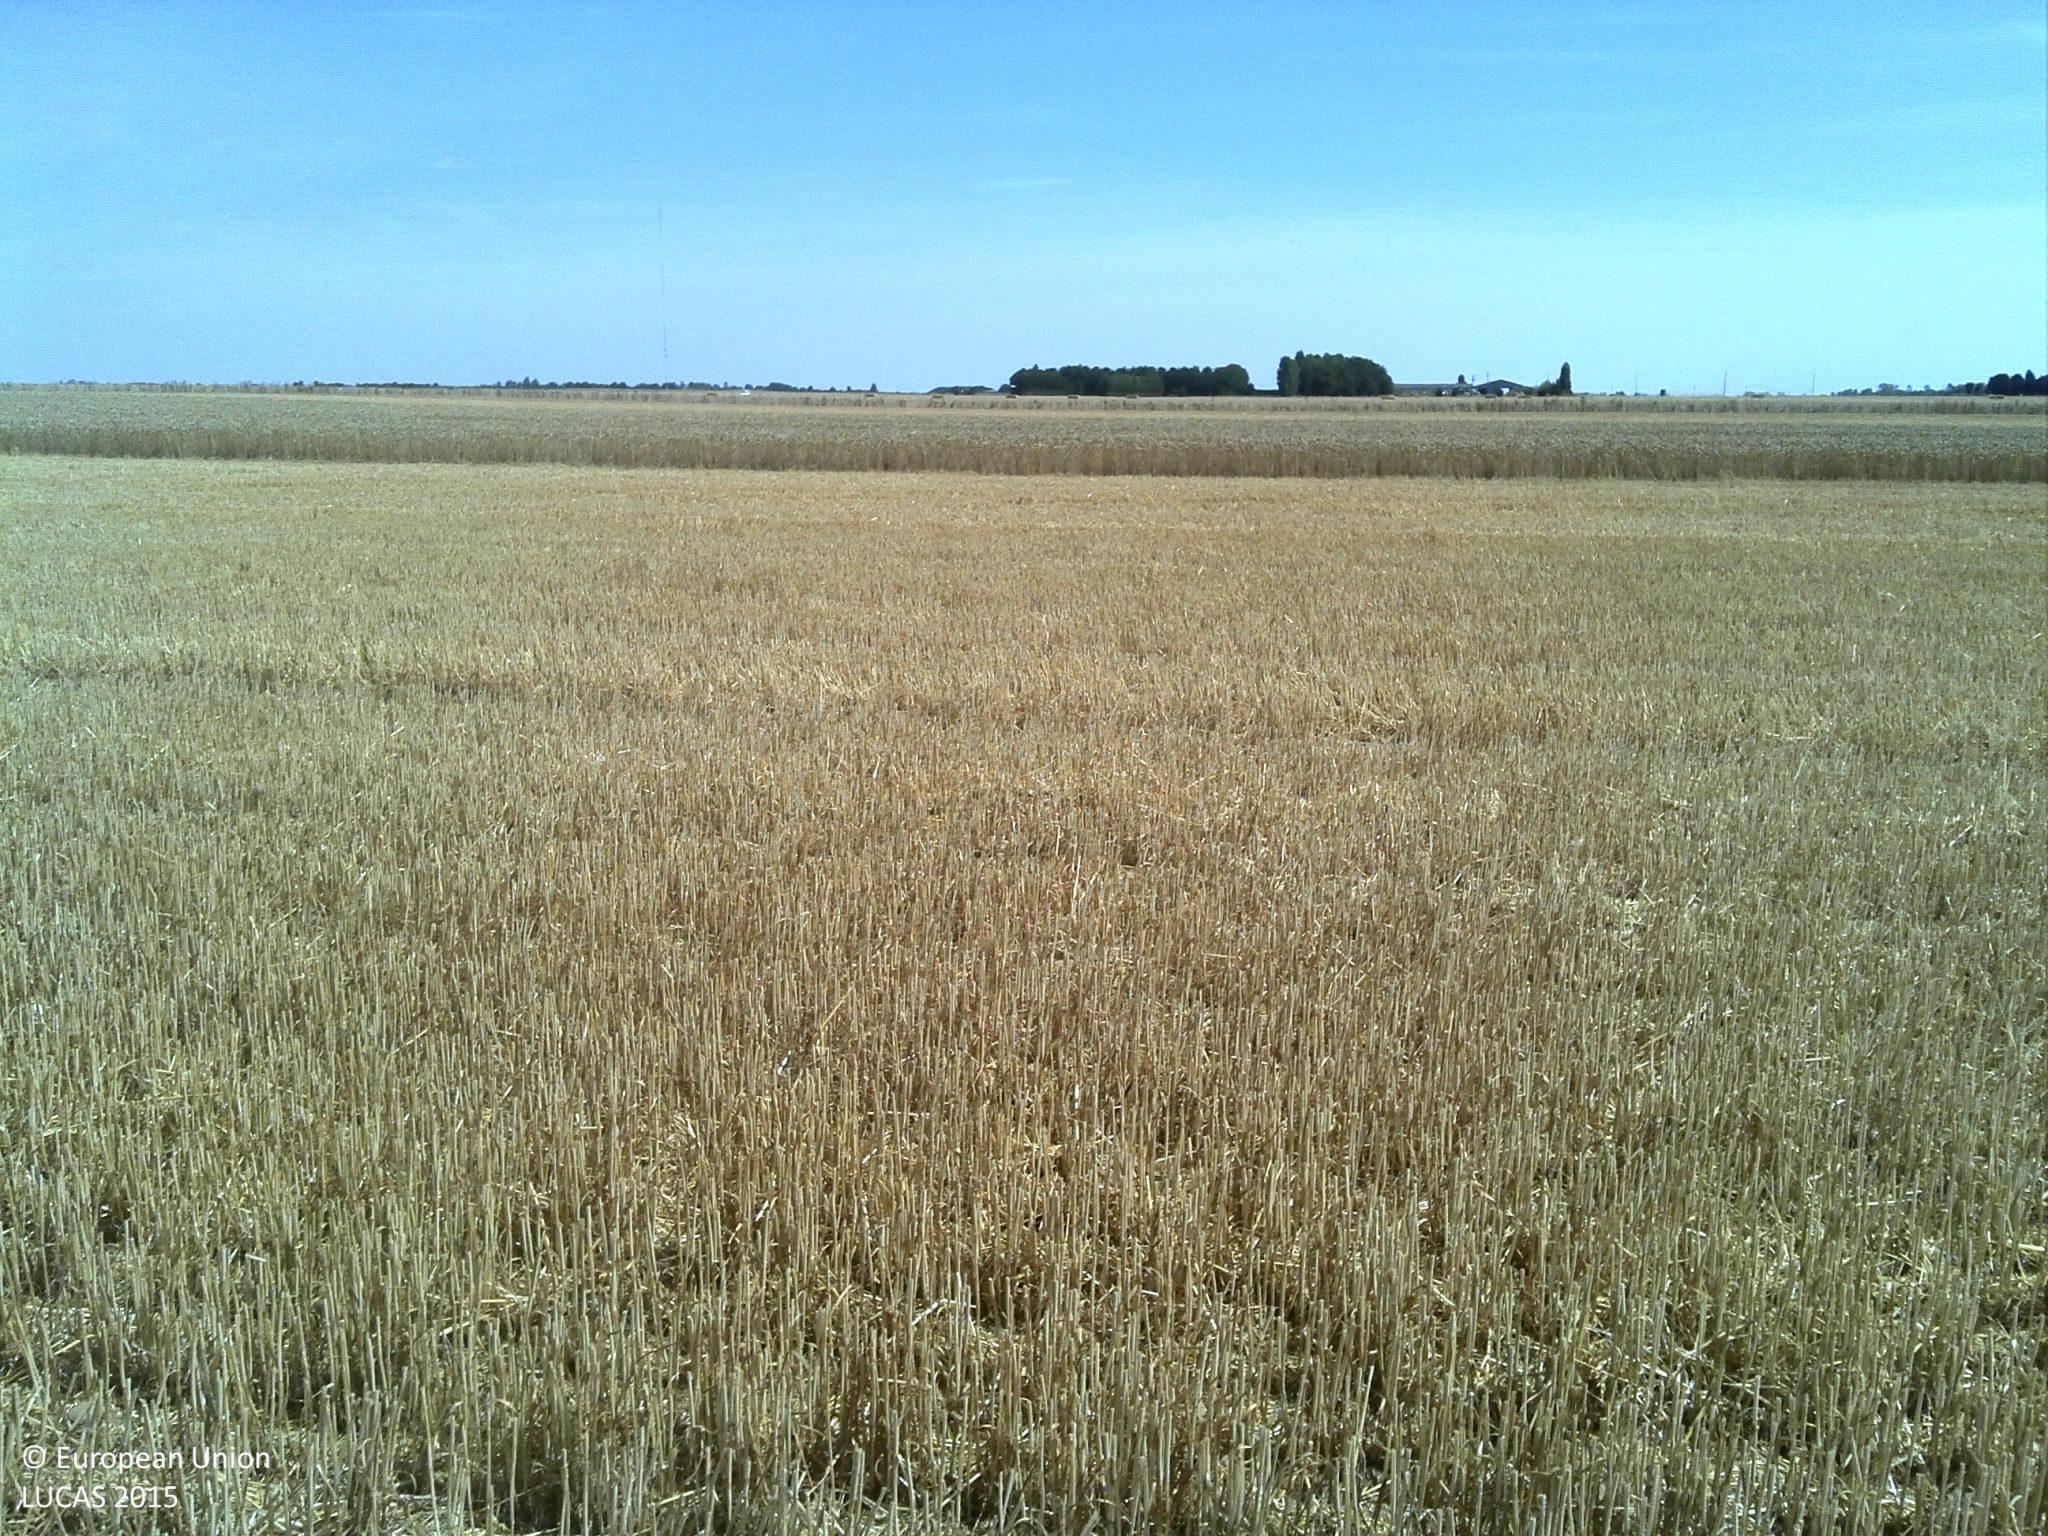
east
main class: Cropland
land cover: Common wheat
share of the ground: > 75 %
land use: Agriculture (excluding fallow land and kitchen gardens)
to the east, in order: Common wheat; Rape and turnip rape; Common wheat
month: July
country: FR
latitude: 48.4665
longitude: 1.8845
